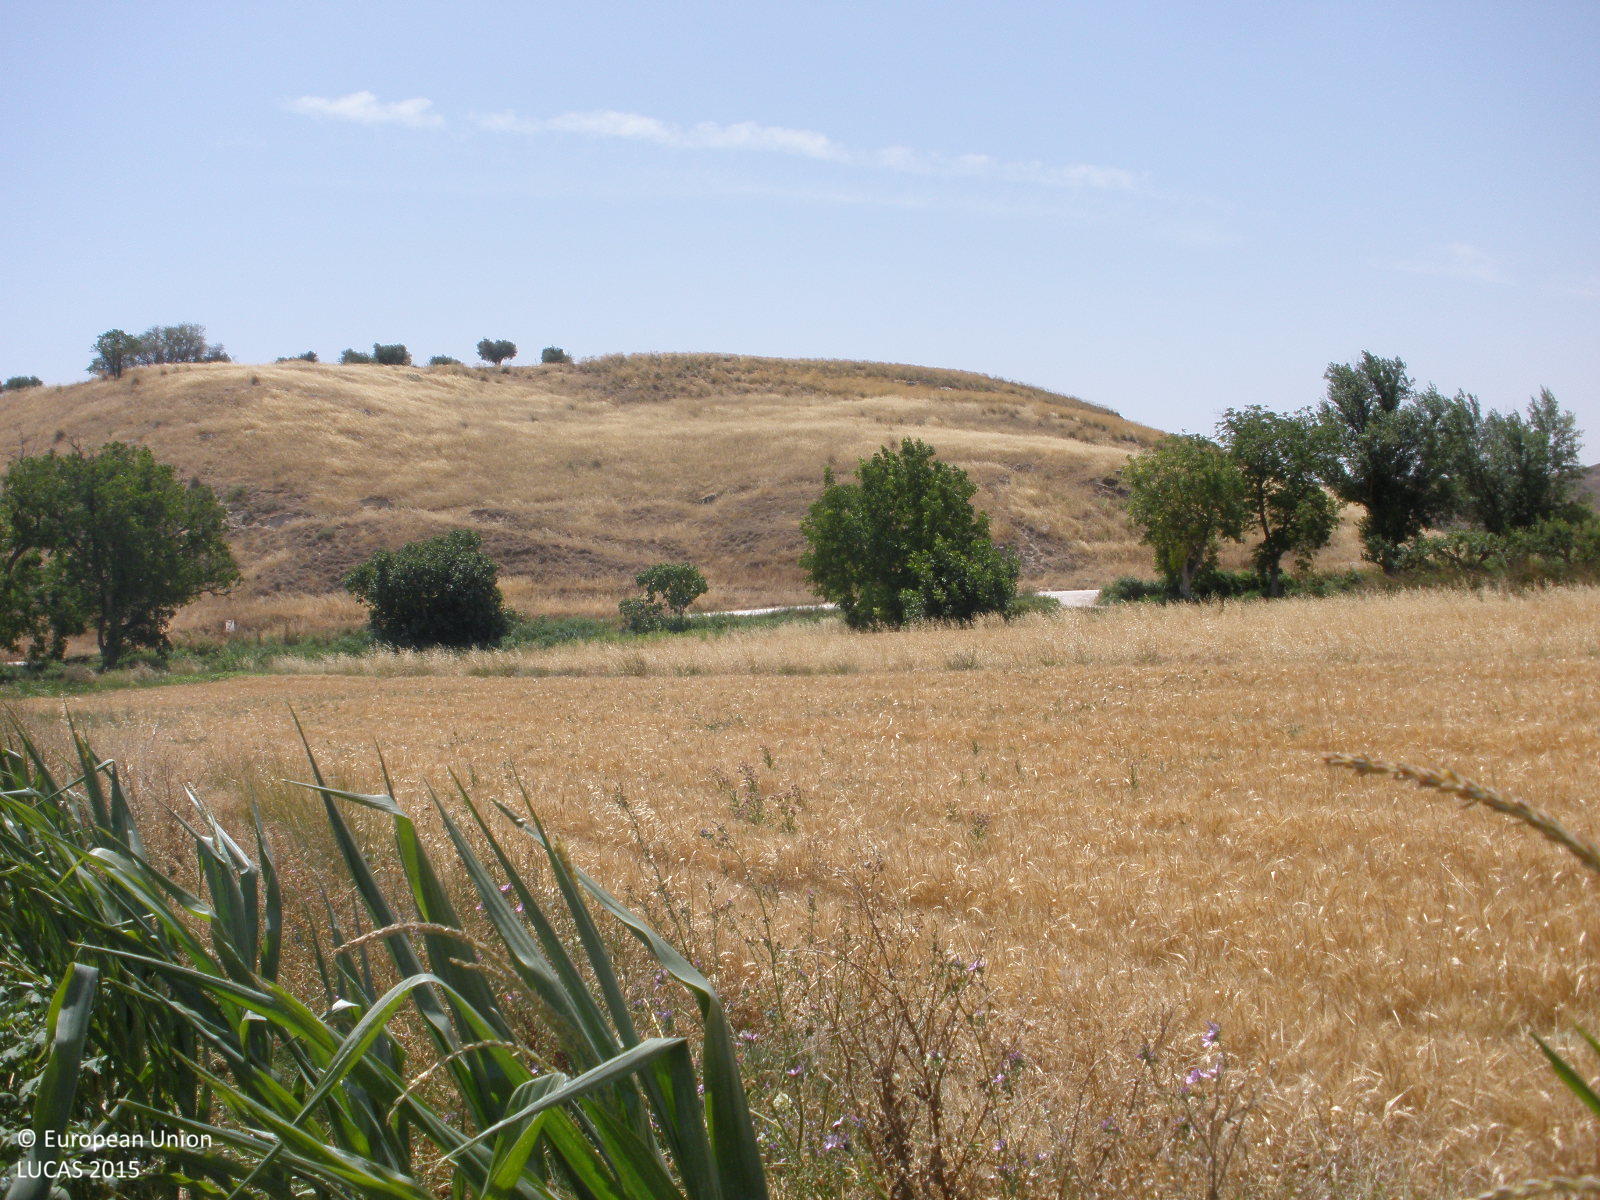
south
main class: Cropland
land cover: Maize
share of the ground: > 75 %
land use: Agriculture (excluding fallow land and kitchen gardens)
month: July
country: ES
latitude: 40.2171
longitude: -3.4389
